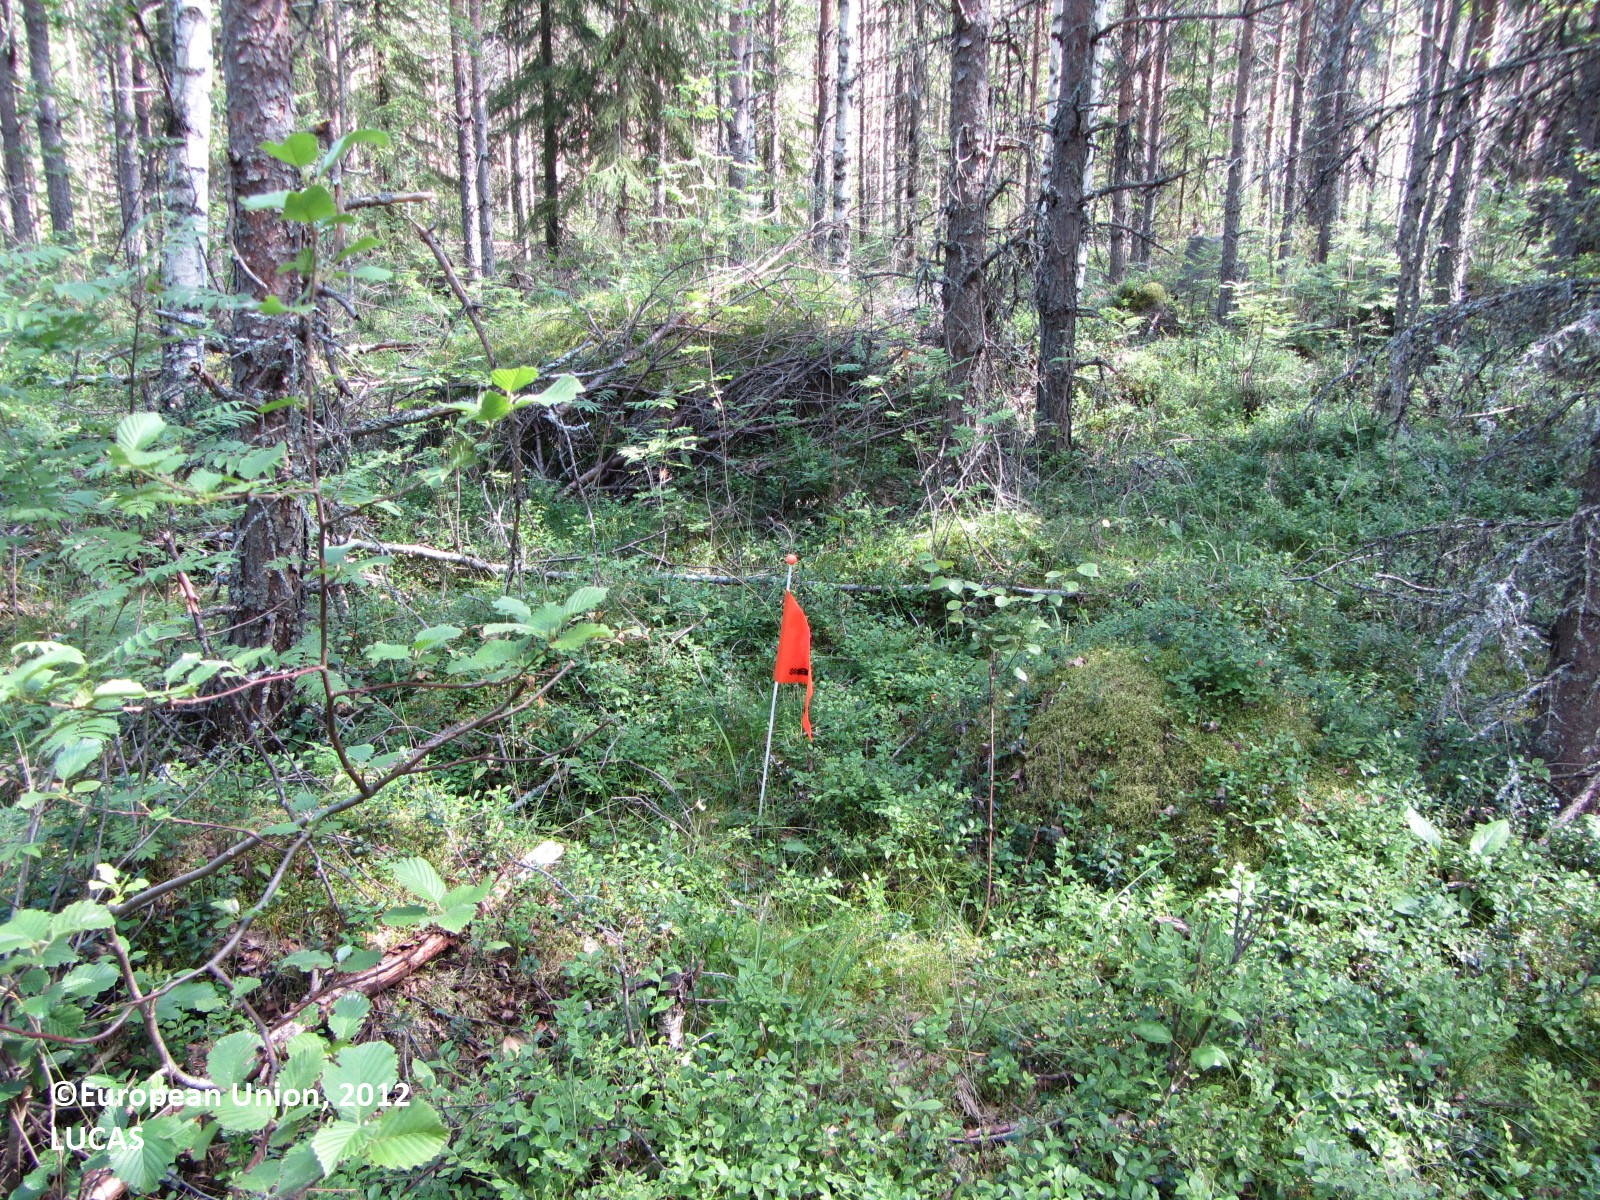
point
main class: Woodland
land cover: Other coniferous woodland
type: boreal forest
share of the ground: > 75 %
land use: Forestry
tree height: > 5 m
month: July
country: FI
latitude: 63.5843
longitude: 24.6484
